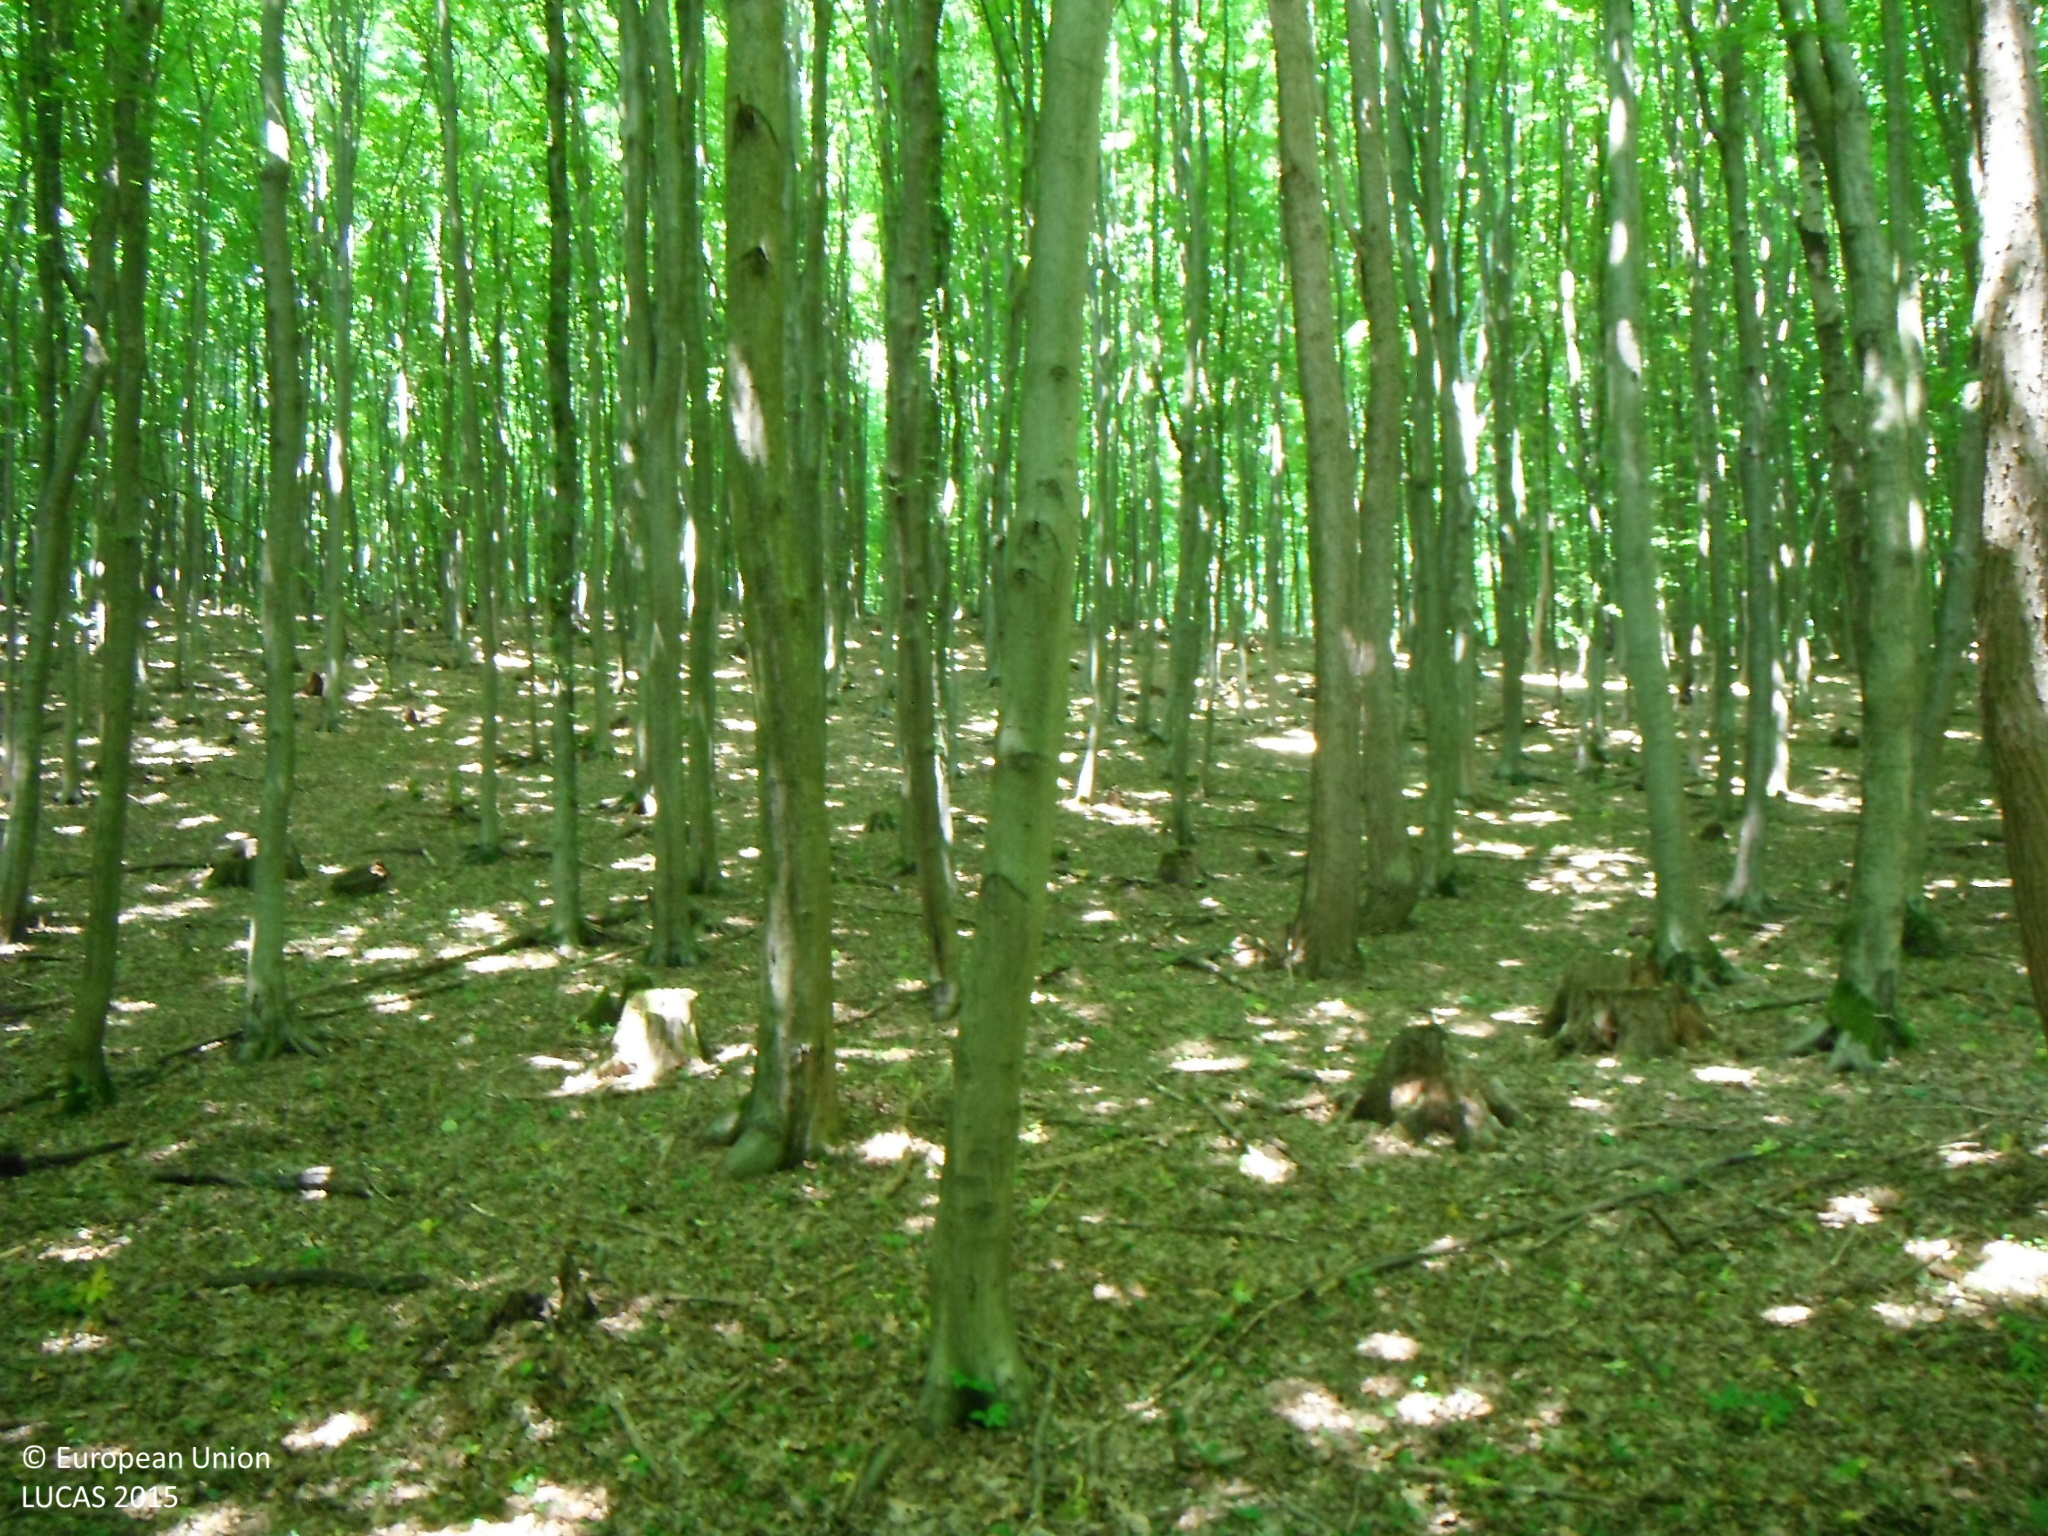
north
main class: Woodland
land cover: Broadleaved woodland
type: mesophytic deciduous forest
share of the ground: > 75 %
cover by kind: broadleaved forest trees 100 %
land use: Forestry
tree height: > 5 m
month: June
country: SK
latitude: 48.4300
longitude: 19.6897
